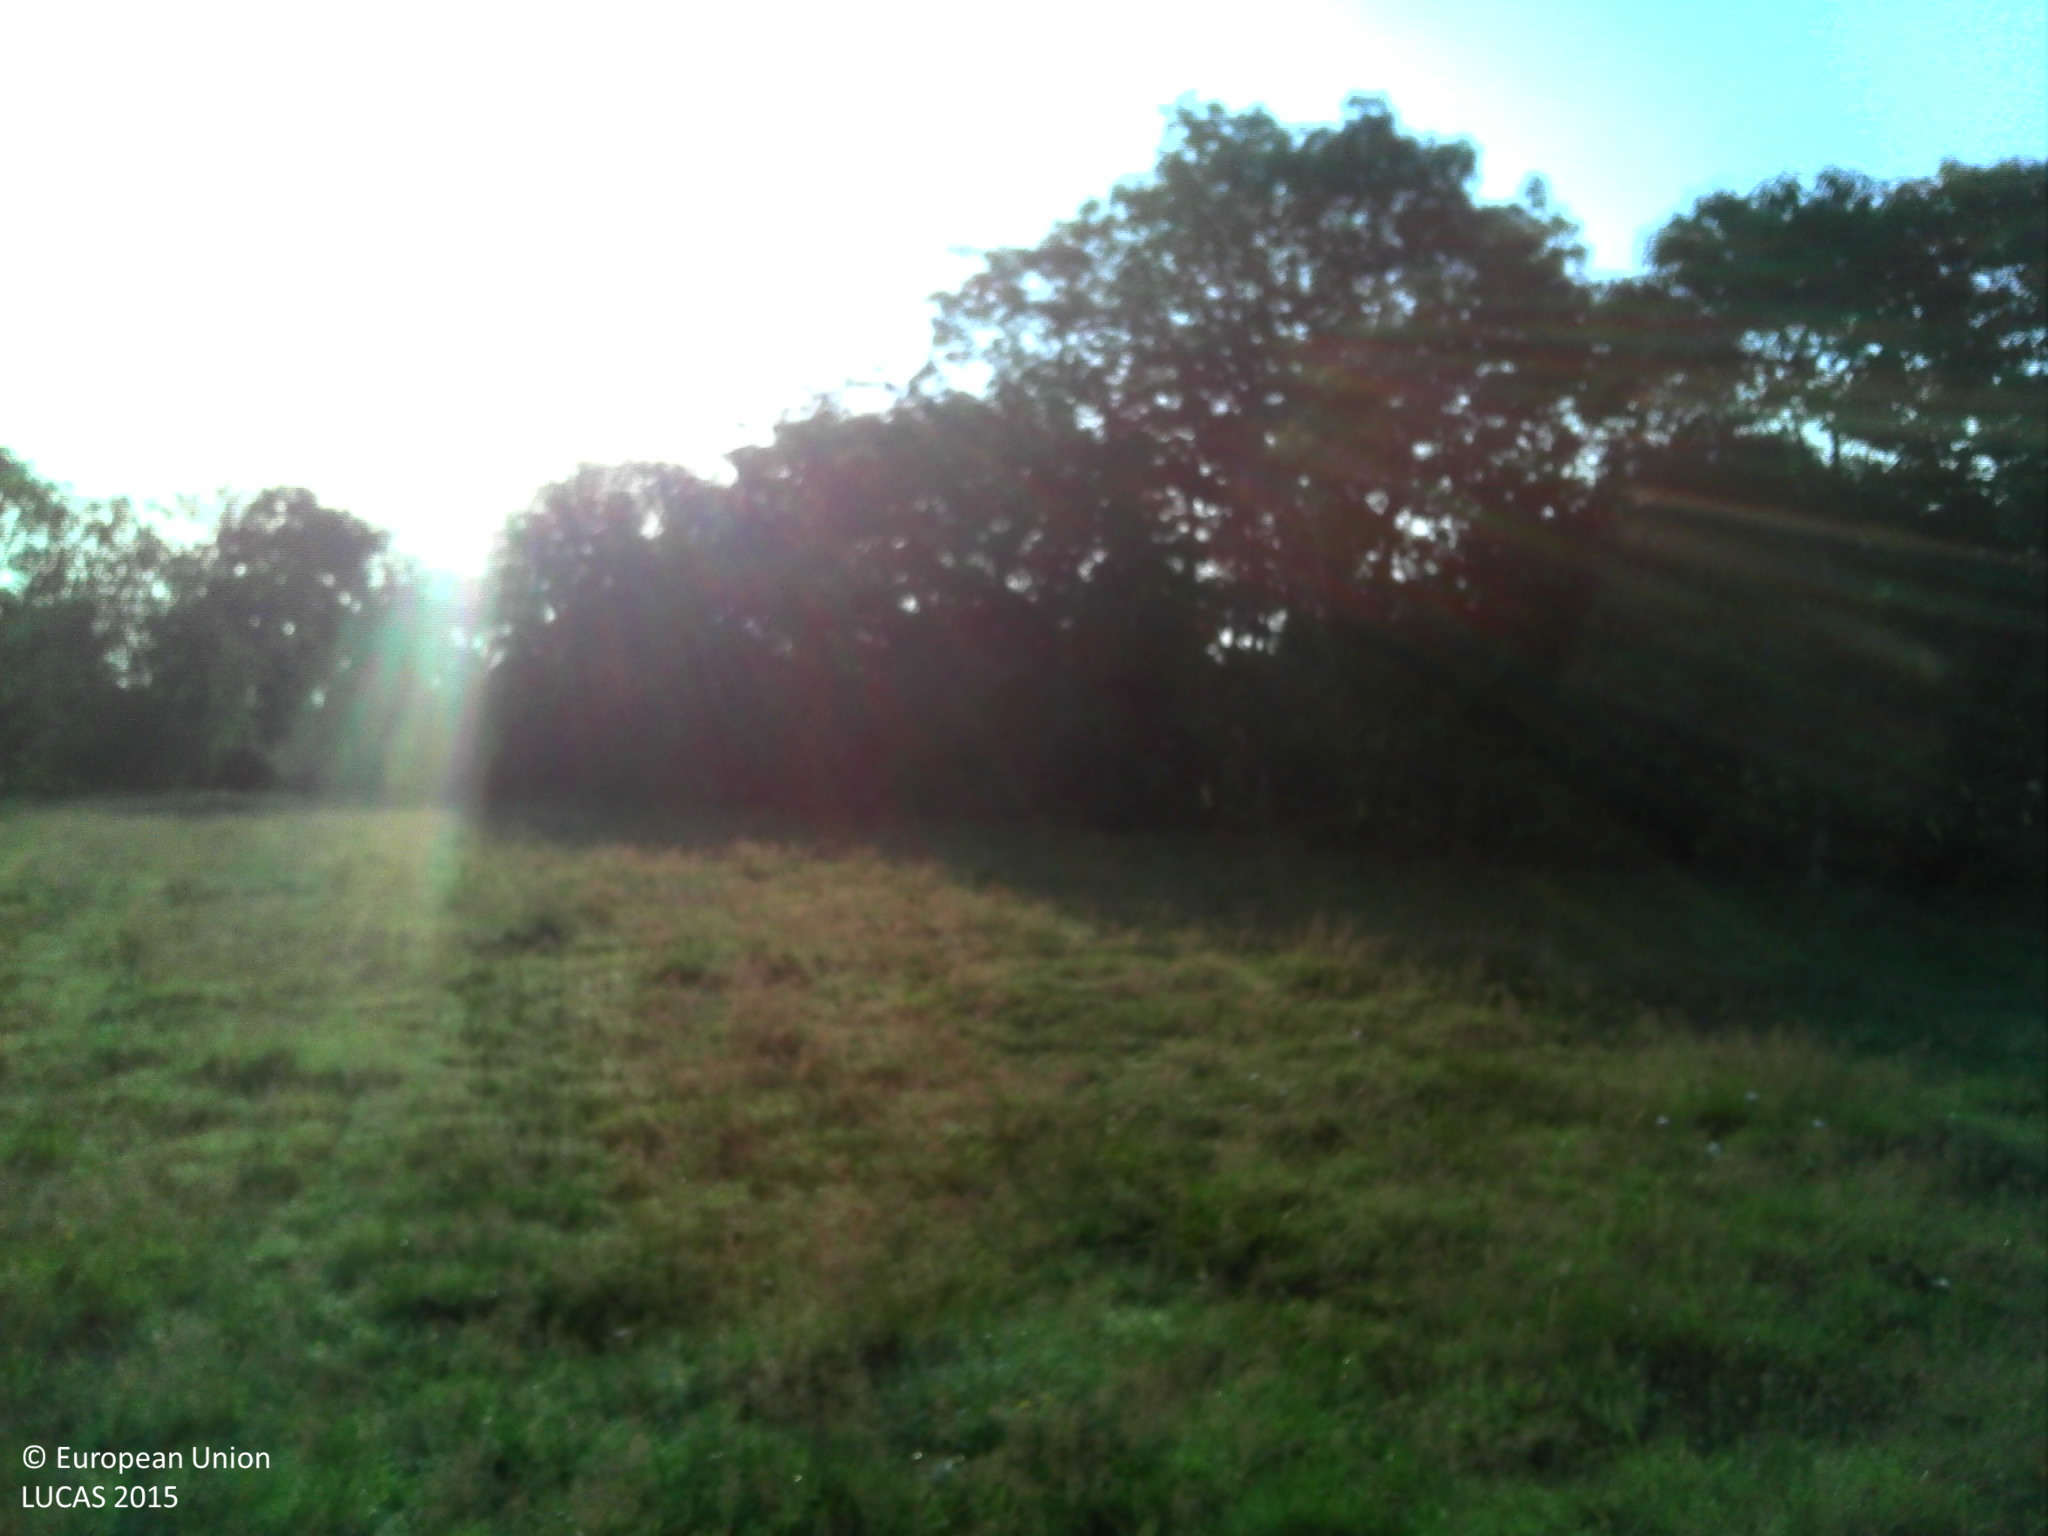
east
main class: Grassland
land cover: Grassland without tree/shrub cover
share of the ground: > 75 %
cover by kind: herbaceous plants 100 %
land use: Agriculture (excluding fallow land and kitchen gardens)
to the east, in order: Grassland without tree/shrub cover; Fences; Broadleaved woodland; Fences; Grassland without tree/shrub cover; Fences; Artificial constructions in urban areas; Grass margins; Paved roads, cycling and walking lanes; Grass margins; Lines of trees; Tracks; Broadleaved woodland; Fences; Grassland without tree/shrub cover; Fences; Broadleaved woodland; Grassland without tree/shrub cover
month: July
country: FR
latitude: 47.3167
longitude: -1.7801
